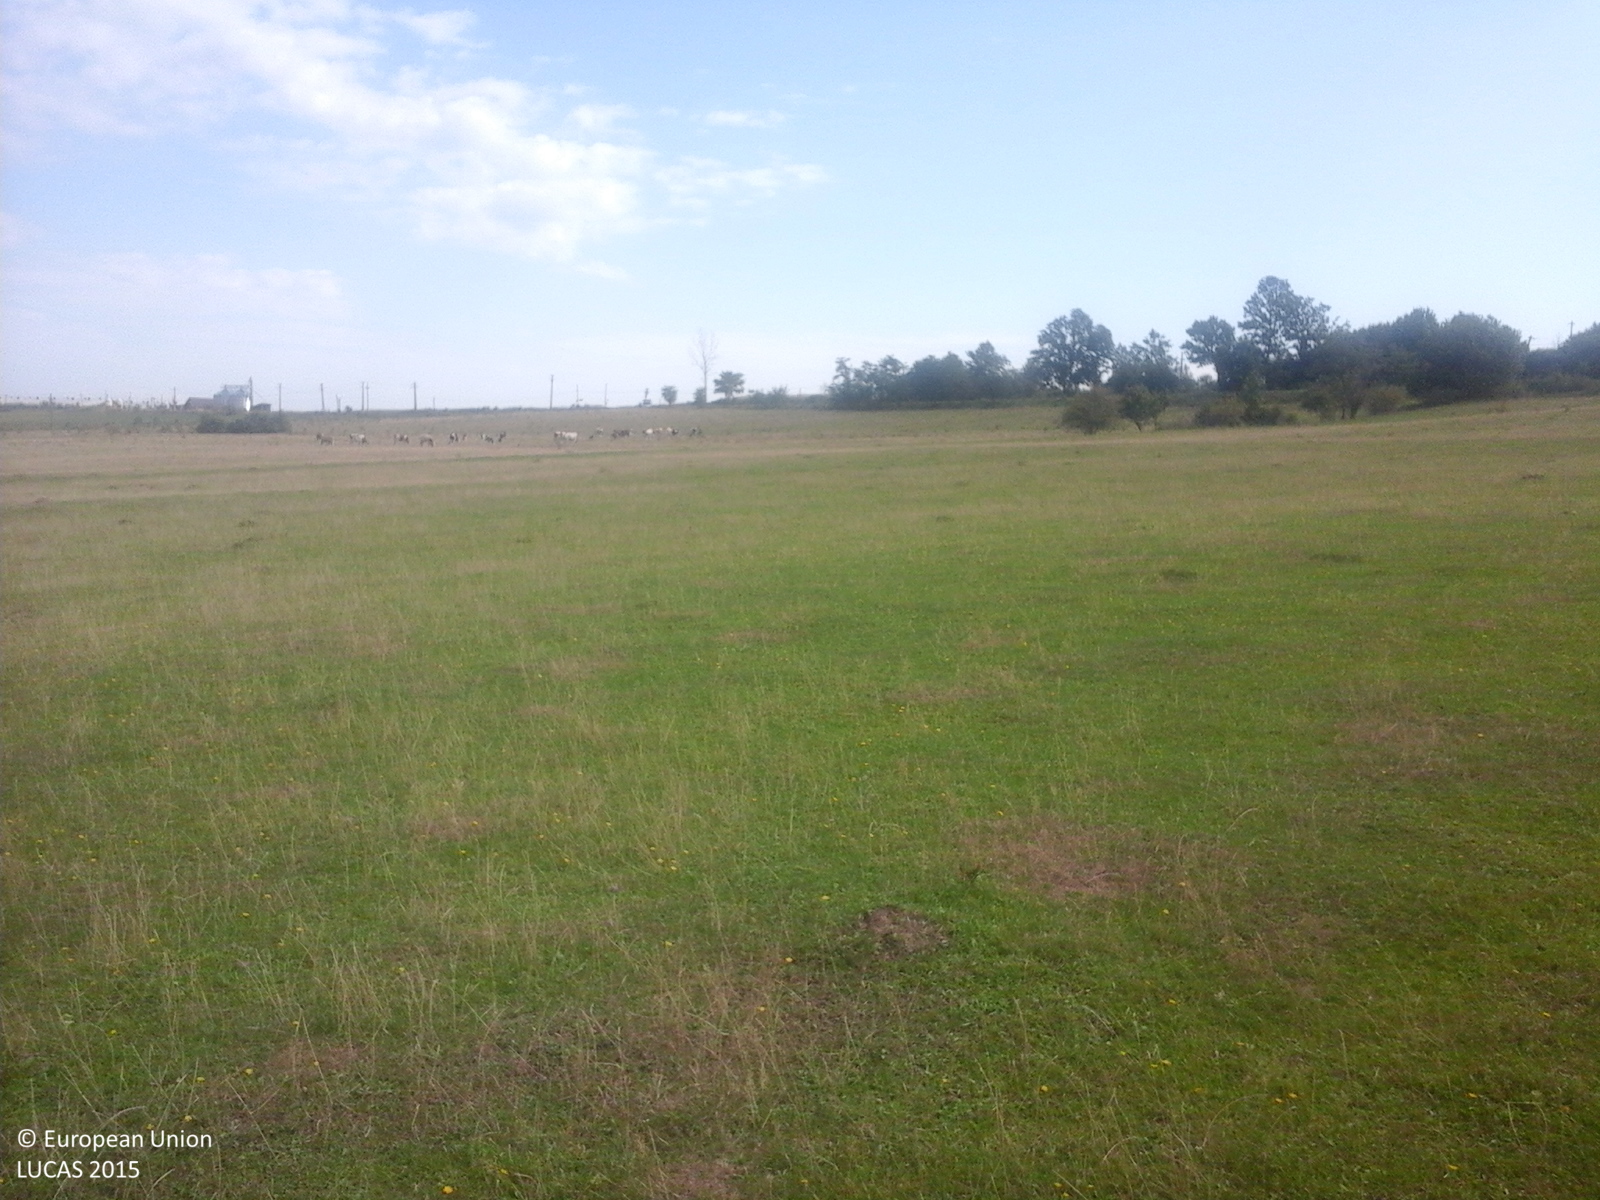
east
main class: Grassland
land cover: Grassland without tree/shrub cover
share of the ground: > 75 %
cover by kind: herbaceous plants 100 %
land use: Agriculture (excluding fallow land and kitchen gardens)
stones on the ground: < 10 %
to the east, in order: Grassland without tree/shrub cover
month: September
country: RO
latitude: 47.3567
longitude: 22.8644
